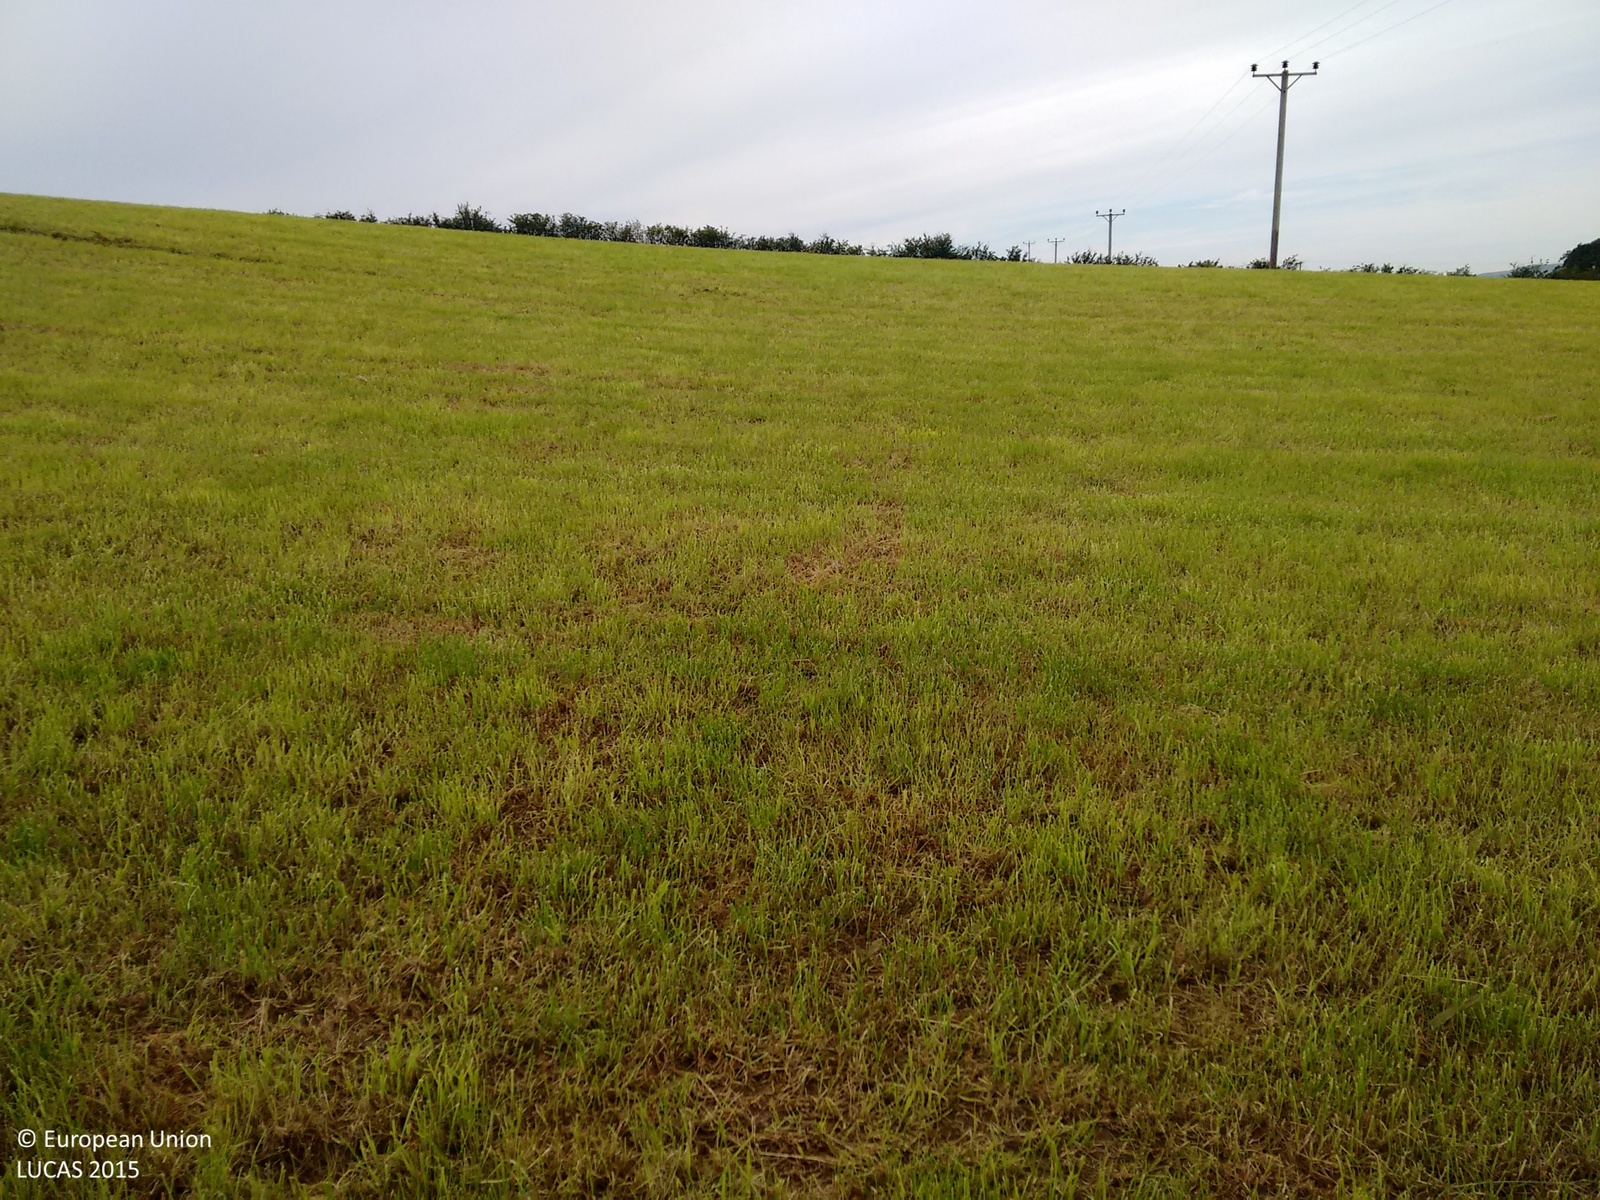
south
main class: Grassland
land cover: Grassland without tree/shrub cover
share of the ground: > 75 %
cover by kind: herbaceous plants 80 %, unconsolidated bare surface 20 %
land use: Agriculture (excluding fallow land and kitchen gardens)
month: August
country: GB
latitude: 55.1553
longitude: -3.3702
